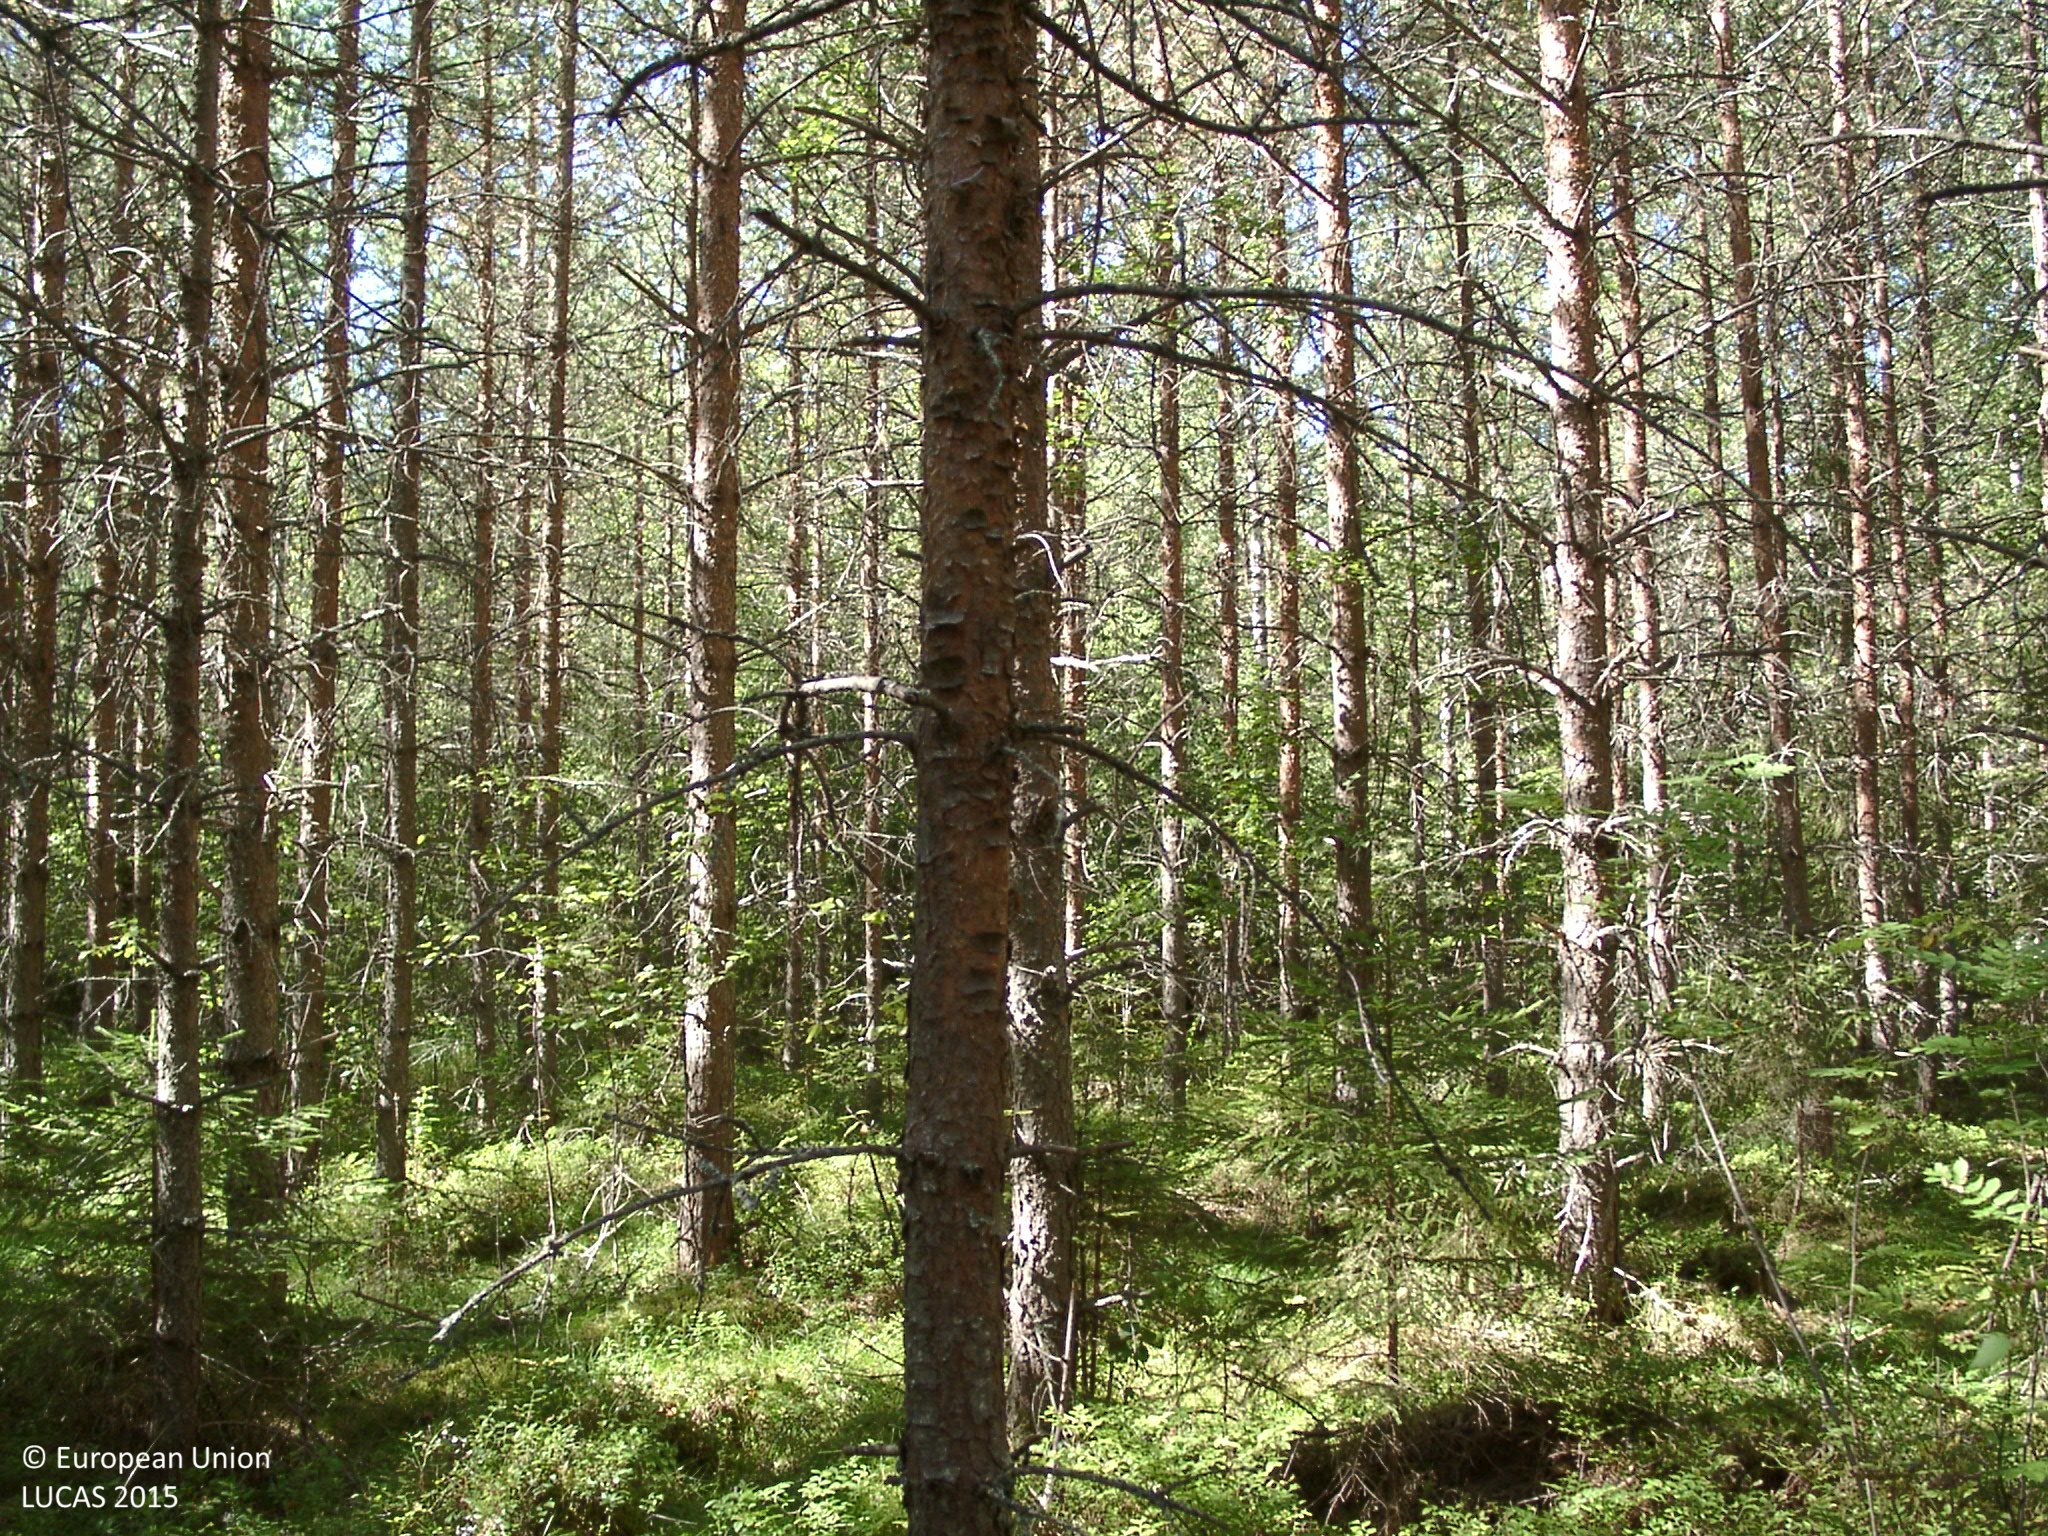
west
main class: Woodland
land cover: Pine dominated coniferous woodland
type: boreal forest
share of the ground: > 75 %
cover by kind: coniferous forest trees 75 %, broadleaved forest trees 10 %, shrubs 10 %, herbaceous plants 5 %
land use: Forestry
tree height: > 5 m
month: August
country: FI
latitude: 62.4423
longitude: 25.1985
